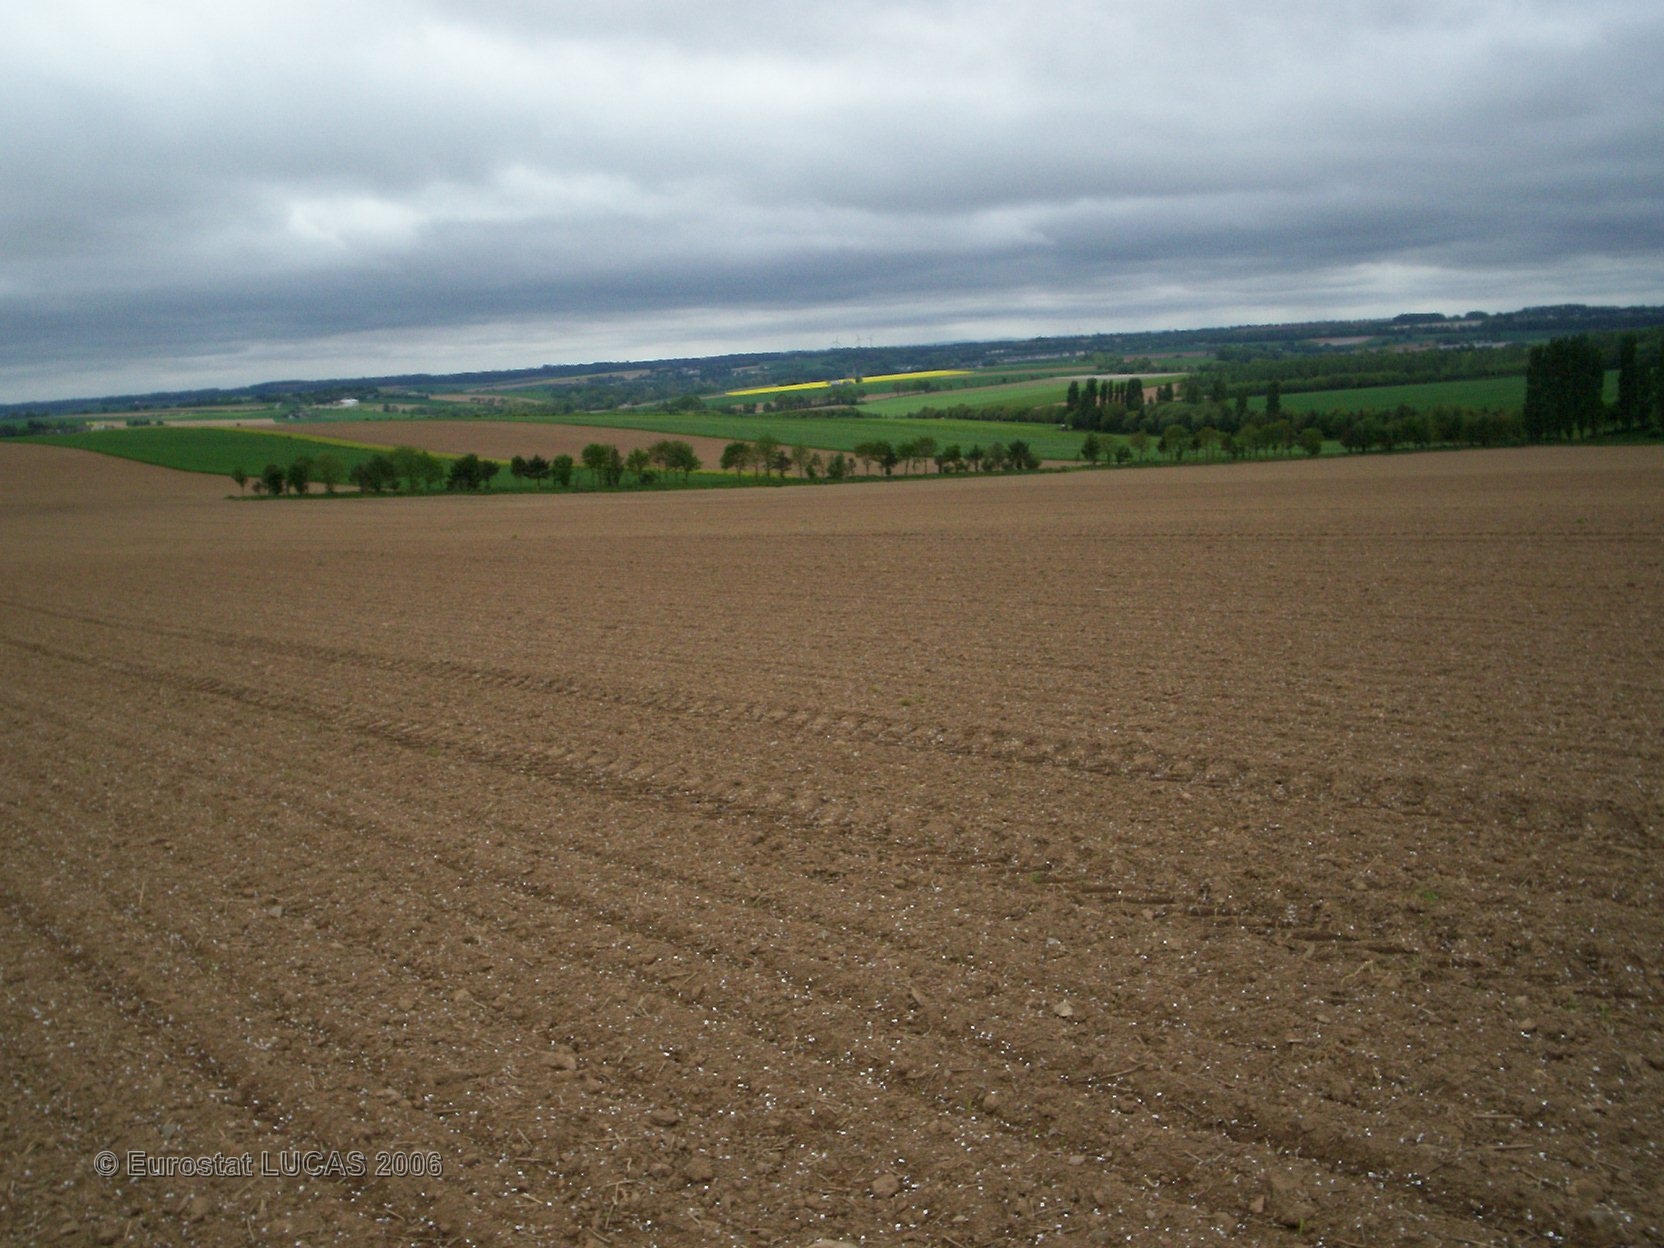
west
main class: Cropland
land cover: Maize
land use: Agriculture (excluding fallow land and kitchen gardens)
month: June
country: FR
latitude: 48.2192
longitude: -2.8118
